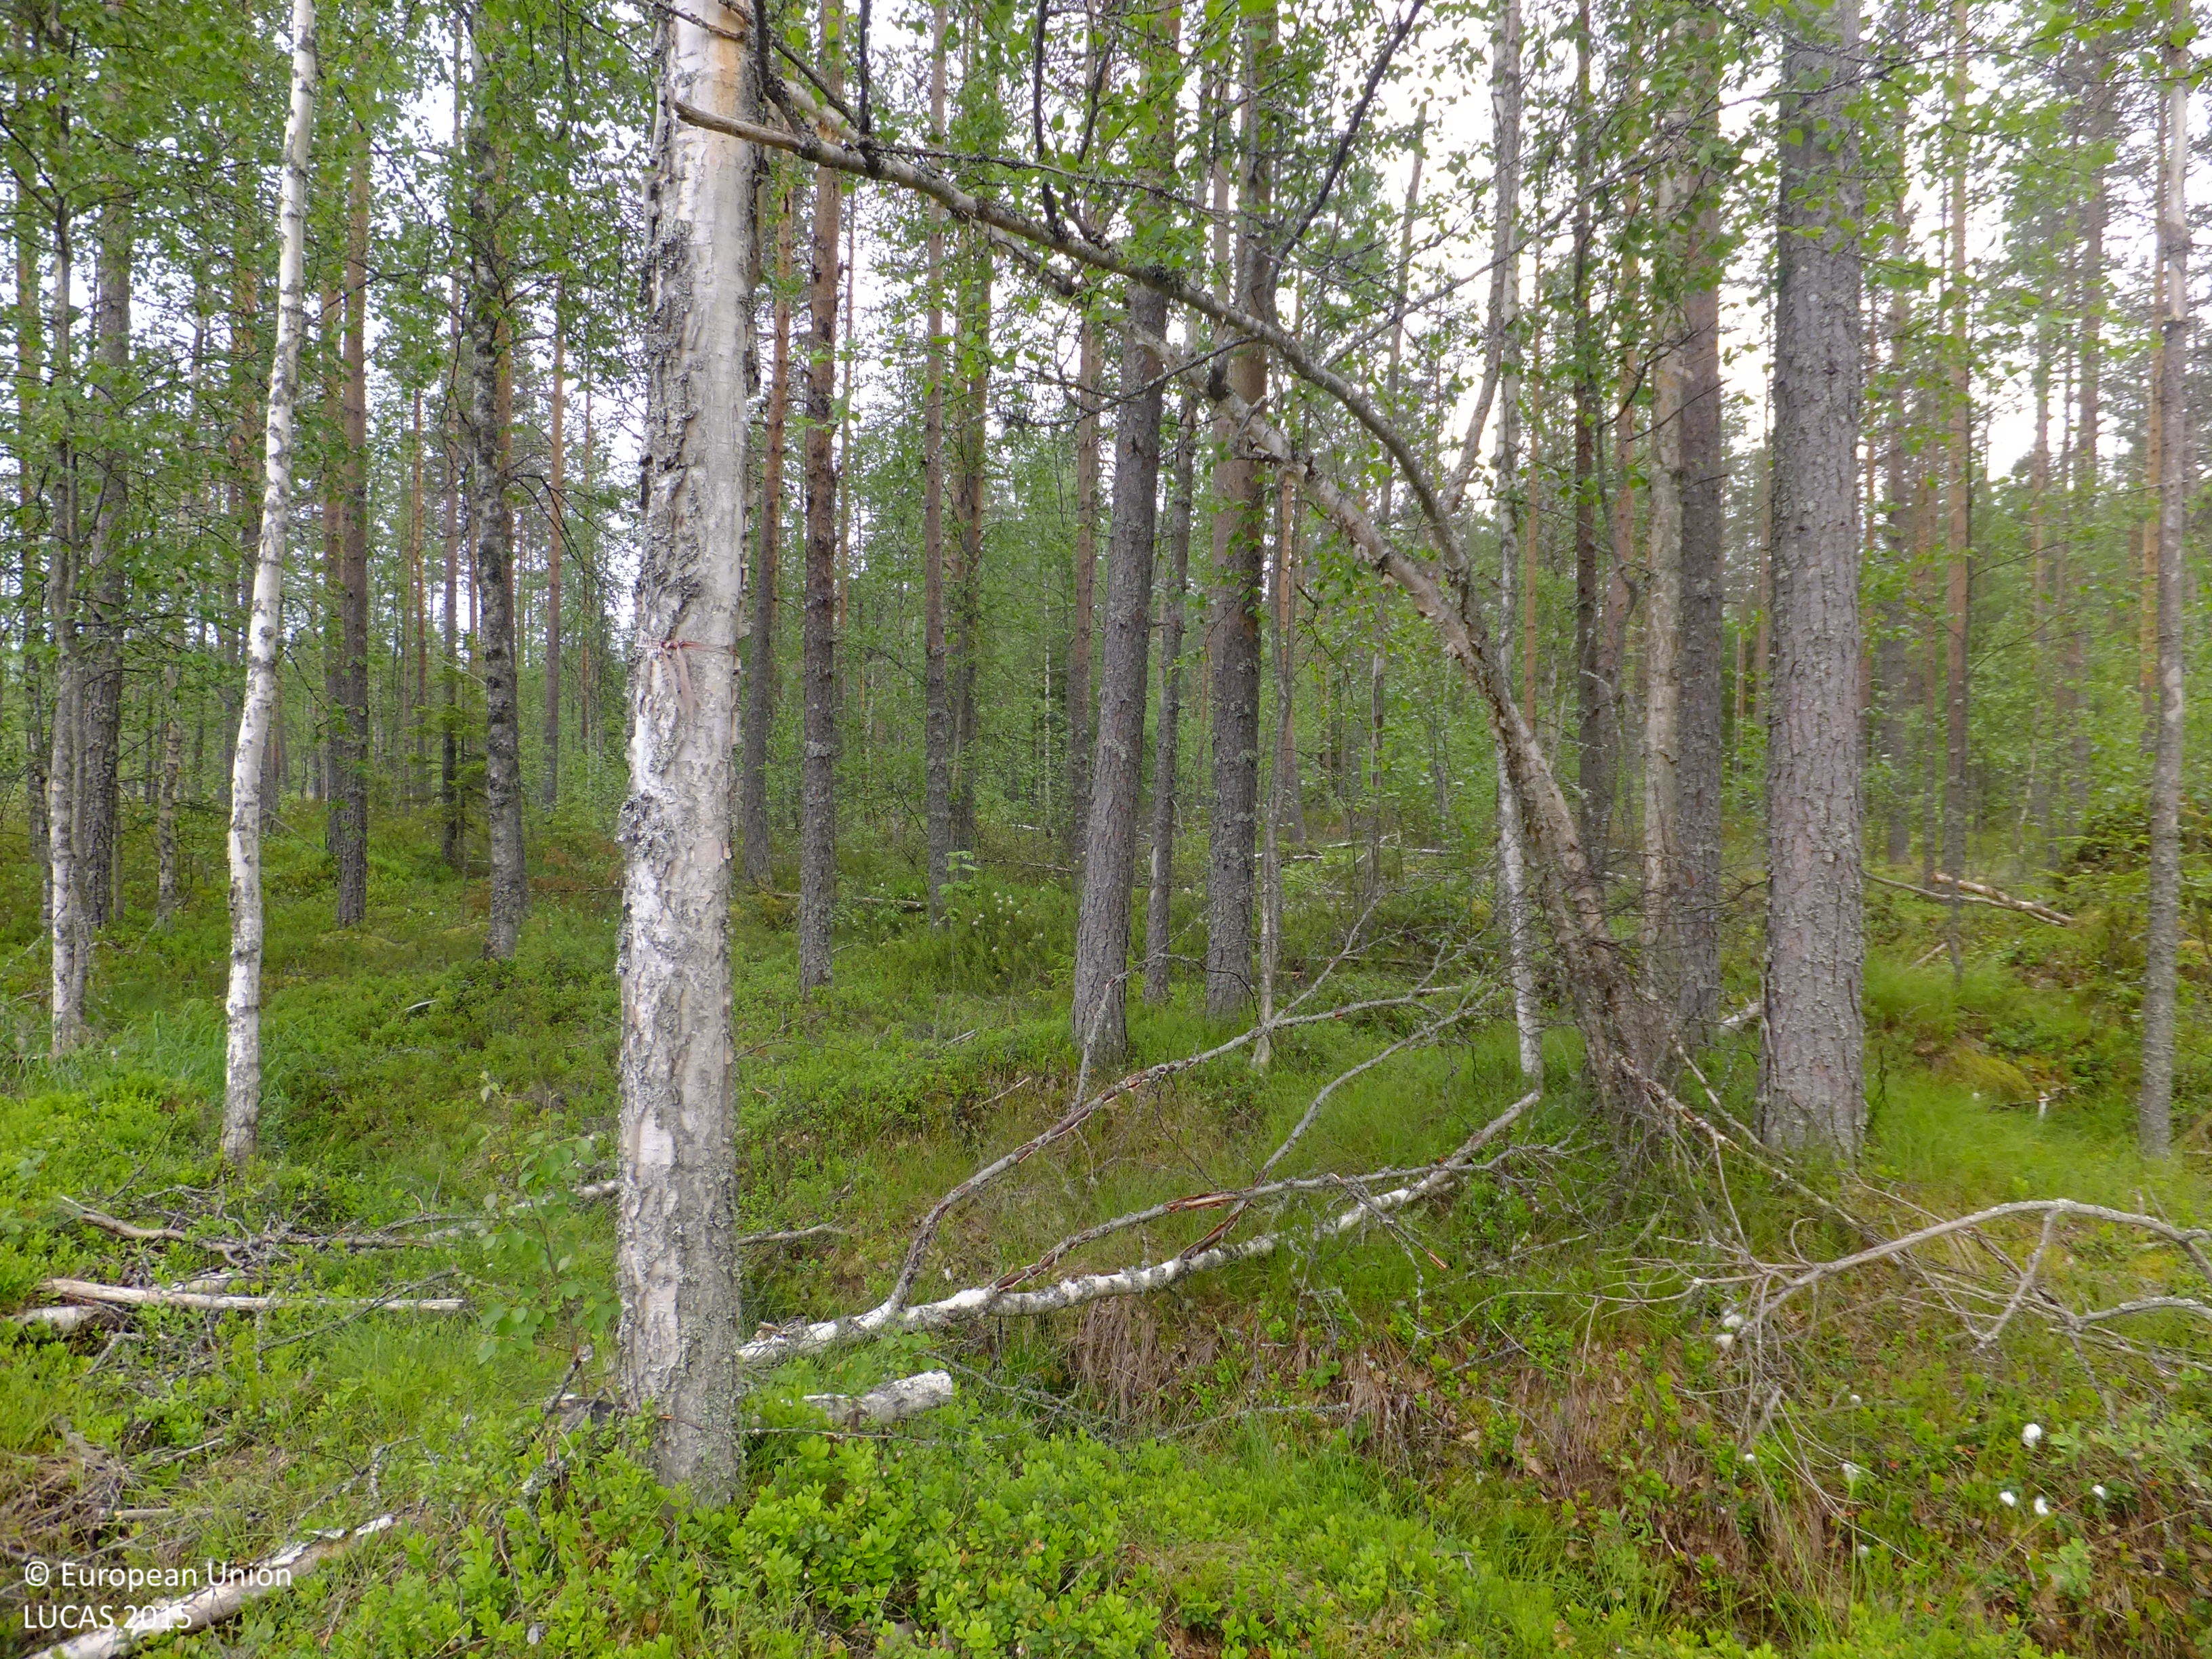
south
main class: Shrubland
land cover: Shrubland with sparse tree cover
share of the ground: 50 - 75 %
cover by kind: shrubs 50 %, herbaceous plants 20 %, lichens and mosses 10 %, unconsolidated bare surface 10 %, broadleaved forest trees 5 %, consolidated bare surface 5 %
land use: Forestry
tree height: > 5 m
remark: Clear cut
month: July
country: FI
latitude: 63.1640
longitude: 24.8021
